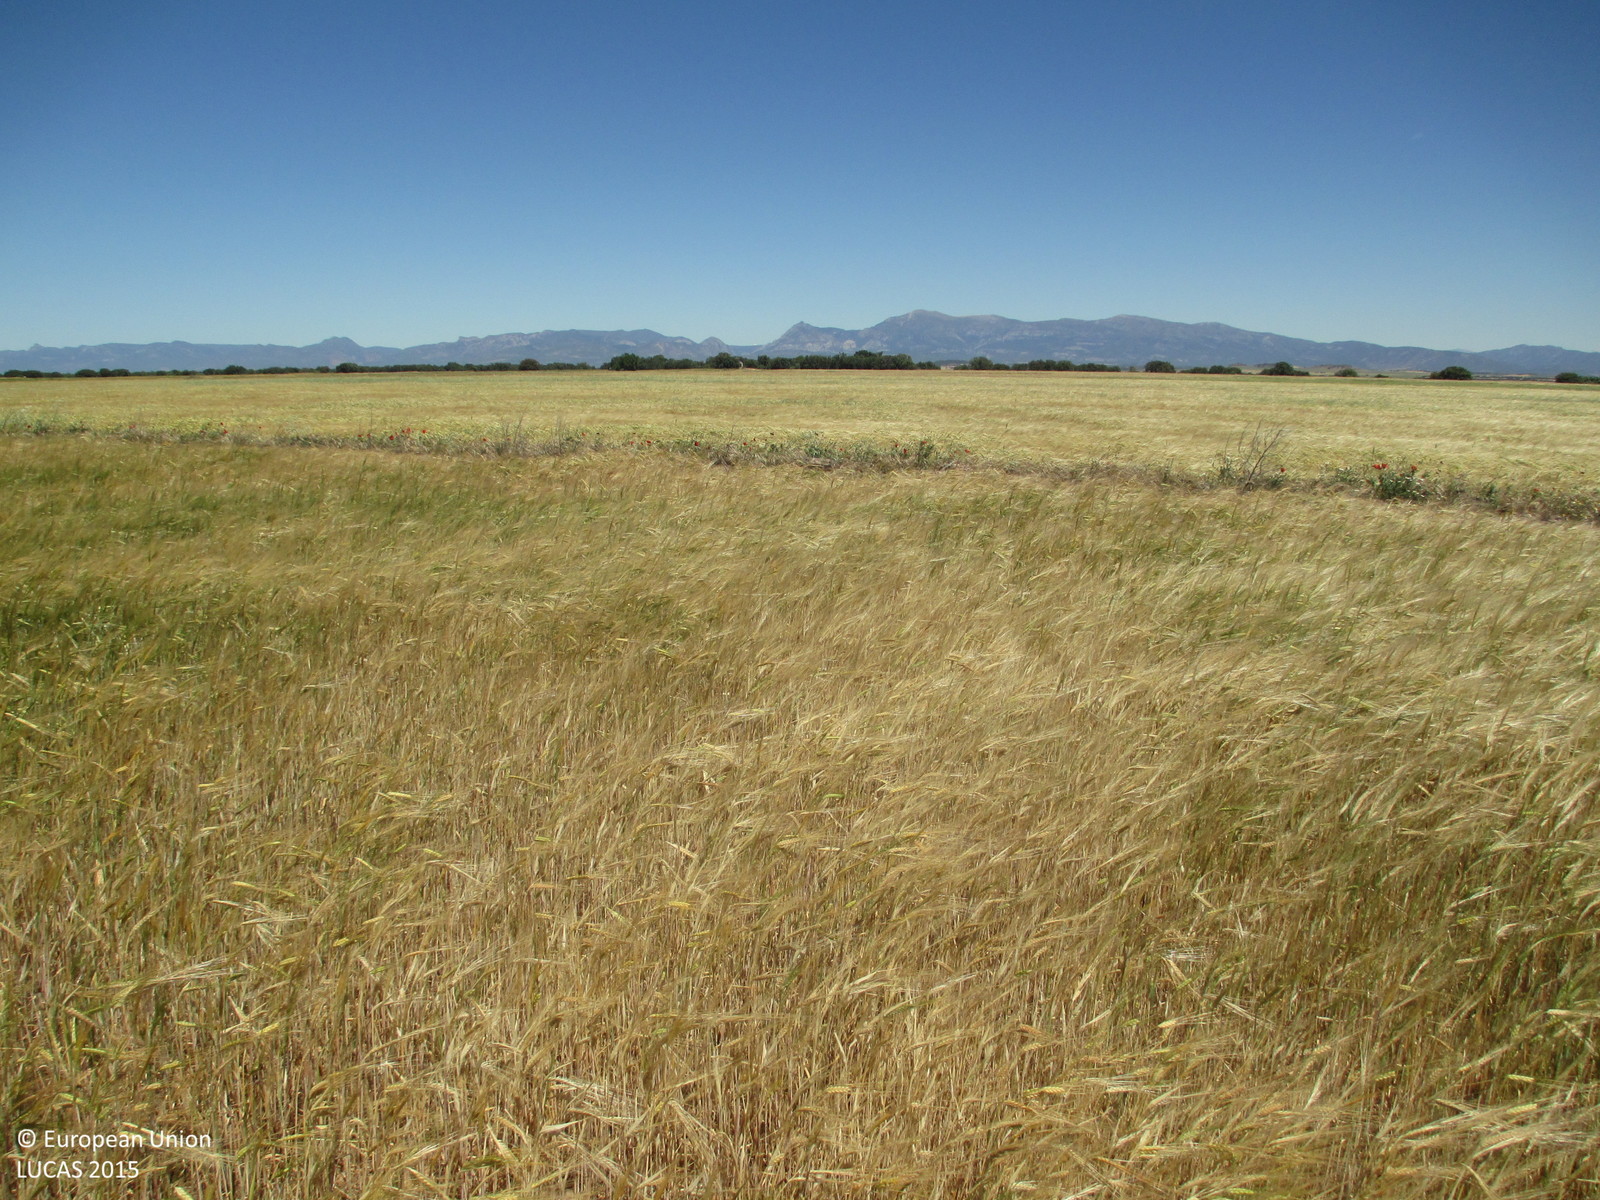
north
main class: Cropland
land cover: Barley
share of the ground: > 75 %
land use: Agriculture (excluding fallow land and kitchen gardens)
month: May
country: ES
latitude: 42.0032
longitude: -0.2708
